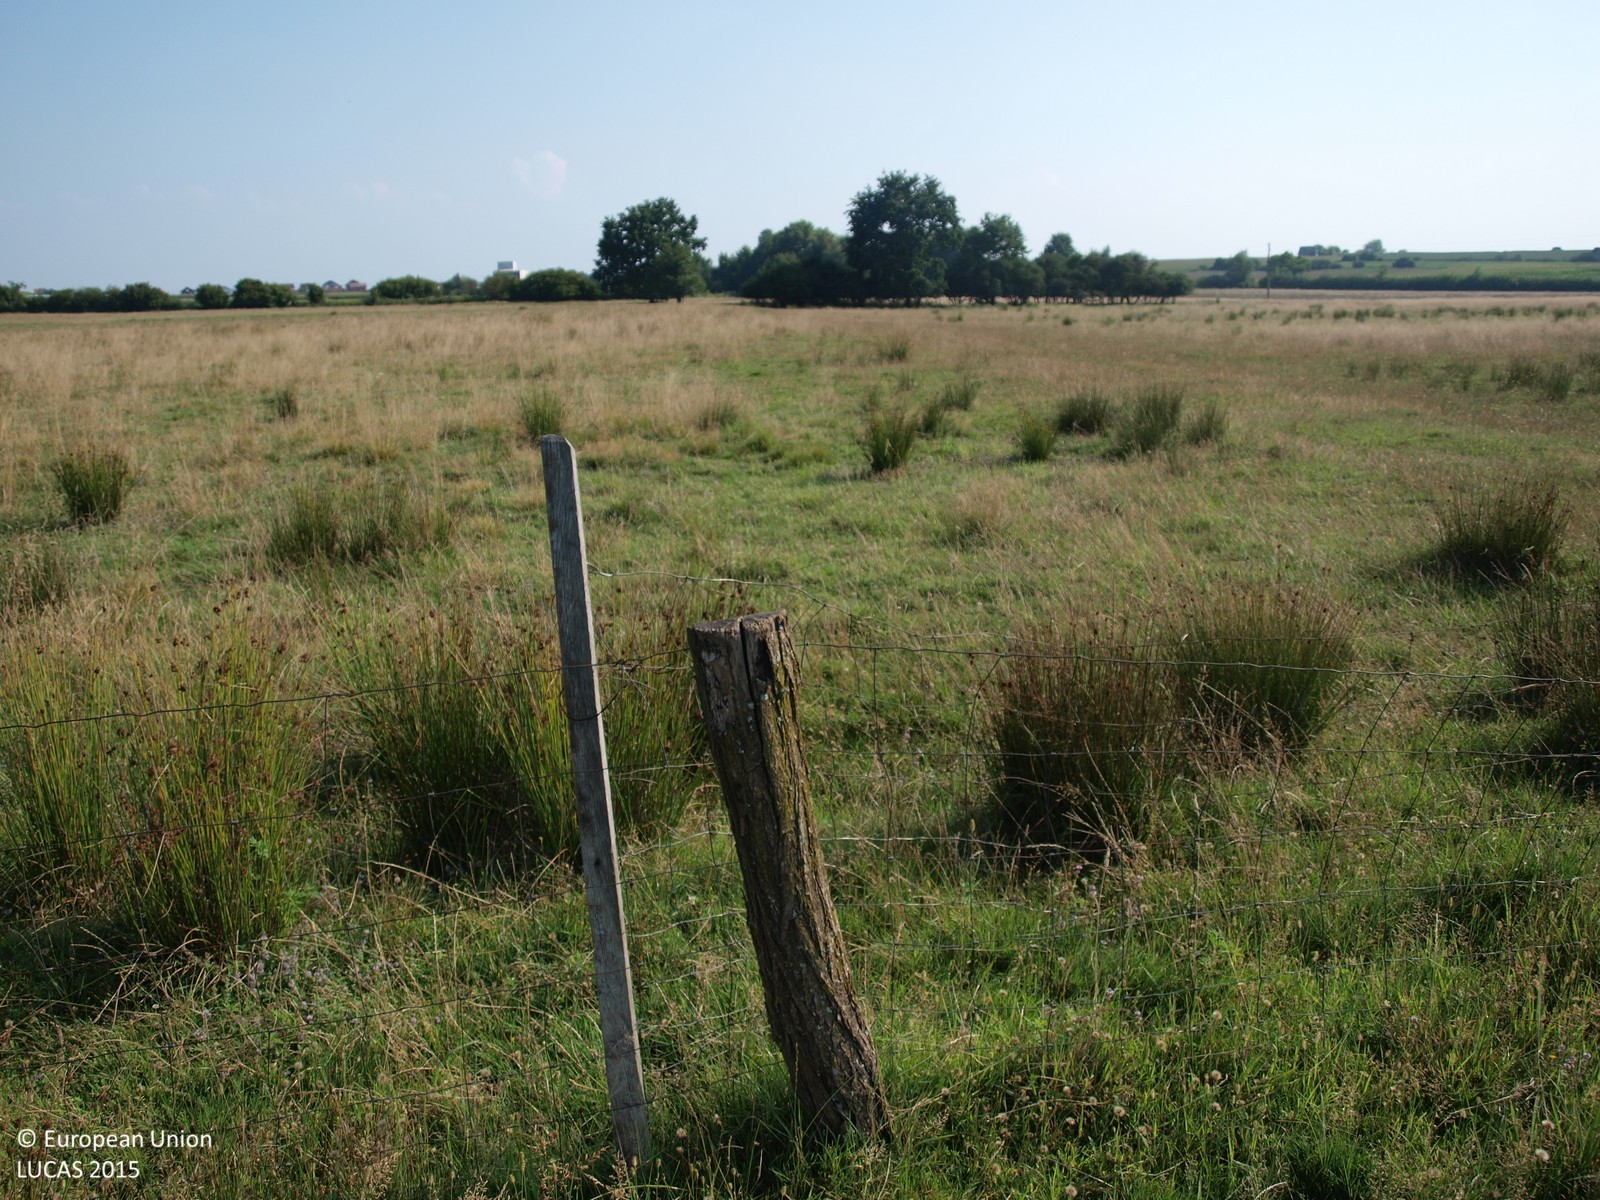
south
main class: Grassland
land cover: Grassland without tree/shrub cover
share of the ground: > 75 %
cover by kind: herbaceous plants 100 %
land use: Agriculture (excluding fallow land and kitchen gardens)
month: August
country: HR
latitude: 45.8446
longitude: 16.5277
